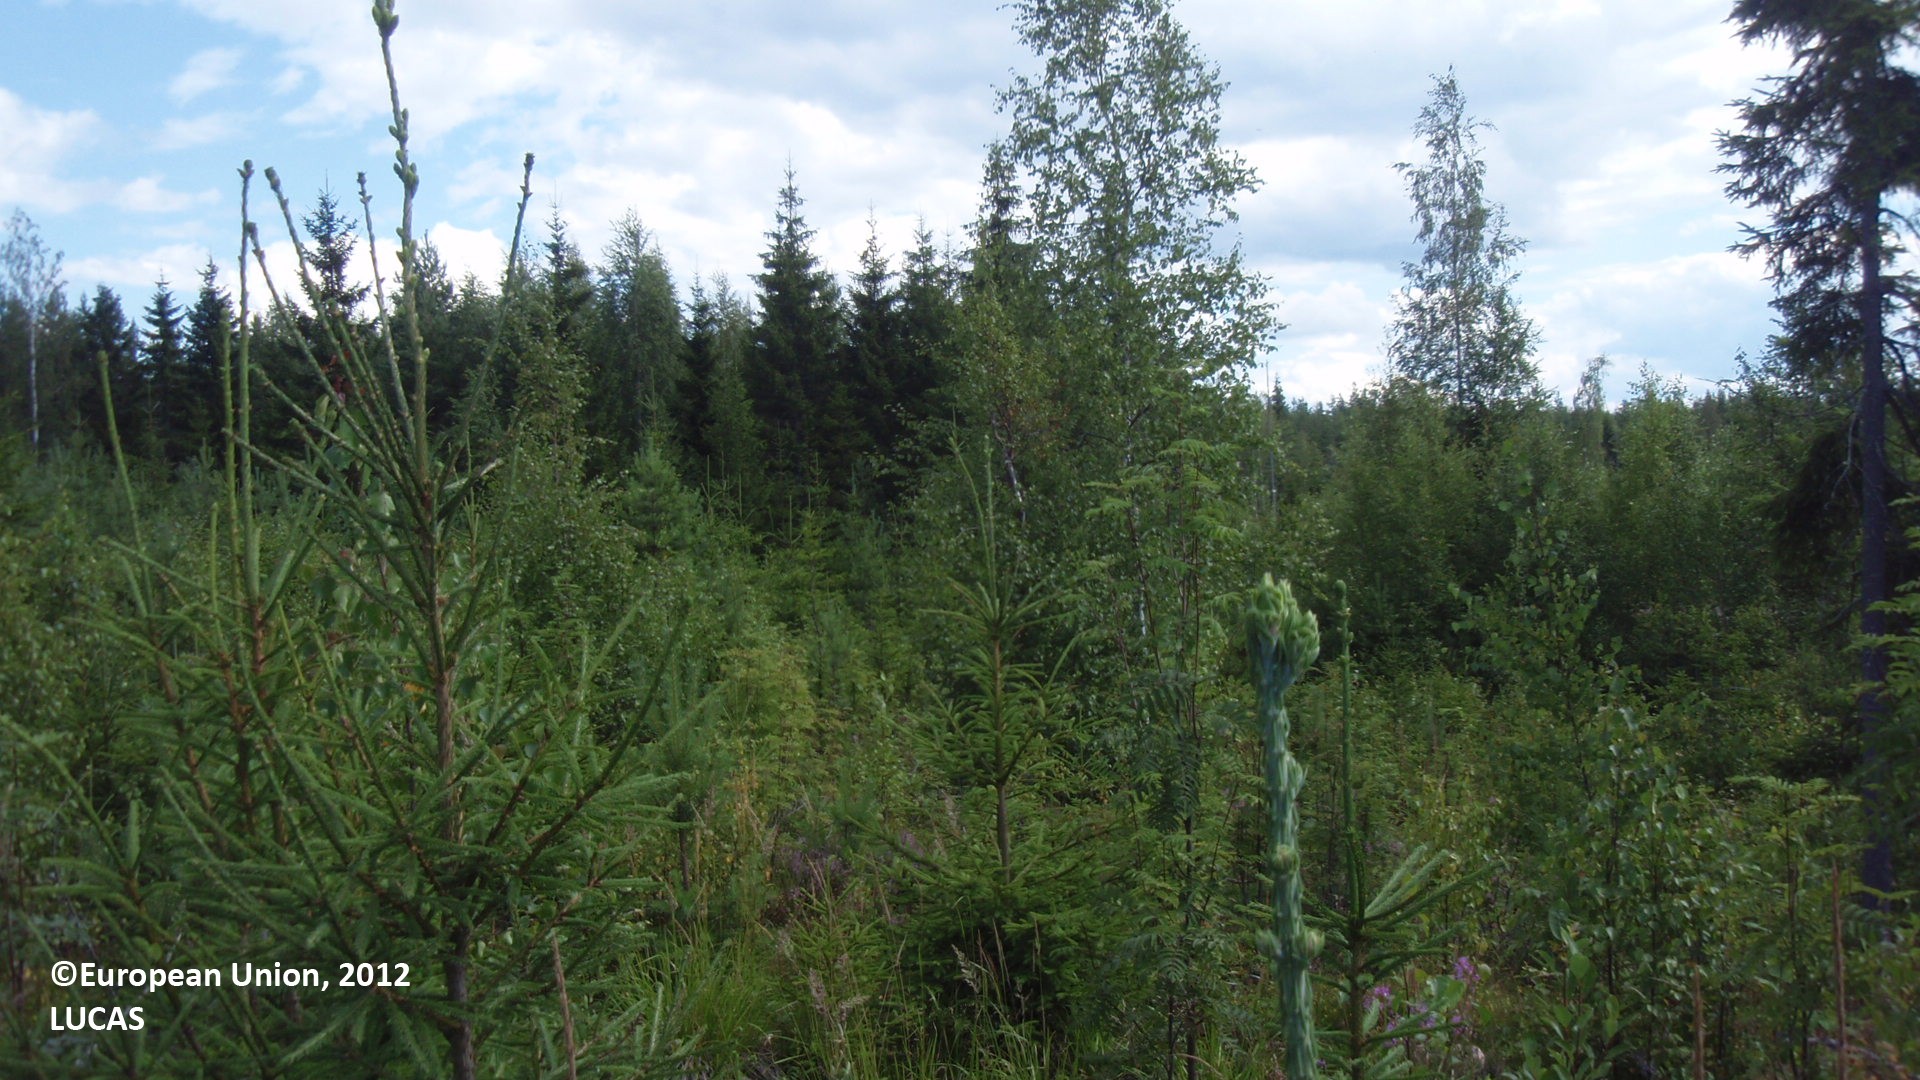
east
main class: Shrubland
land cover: Shrubland with sparse tree cover
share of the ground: > 75 %
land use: Forestry
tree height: < 5 m
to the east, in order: Shrubland with sparse tree cover; Spruce dominated mixed woodland; Shrubland with sparse tree cover; Pine dominated mixed woodland; Spruce dominated mixed woodland
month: July
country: FI
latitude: 61.4313
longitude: 28.9174
